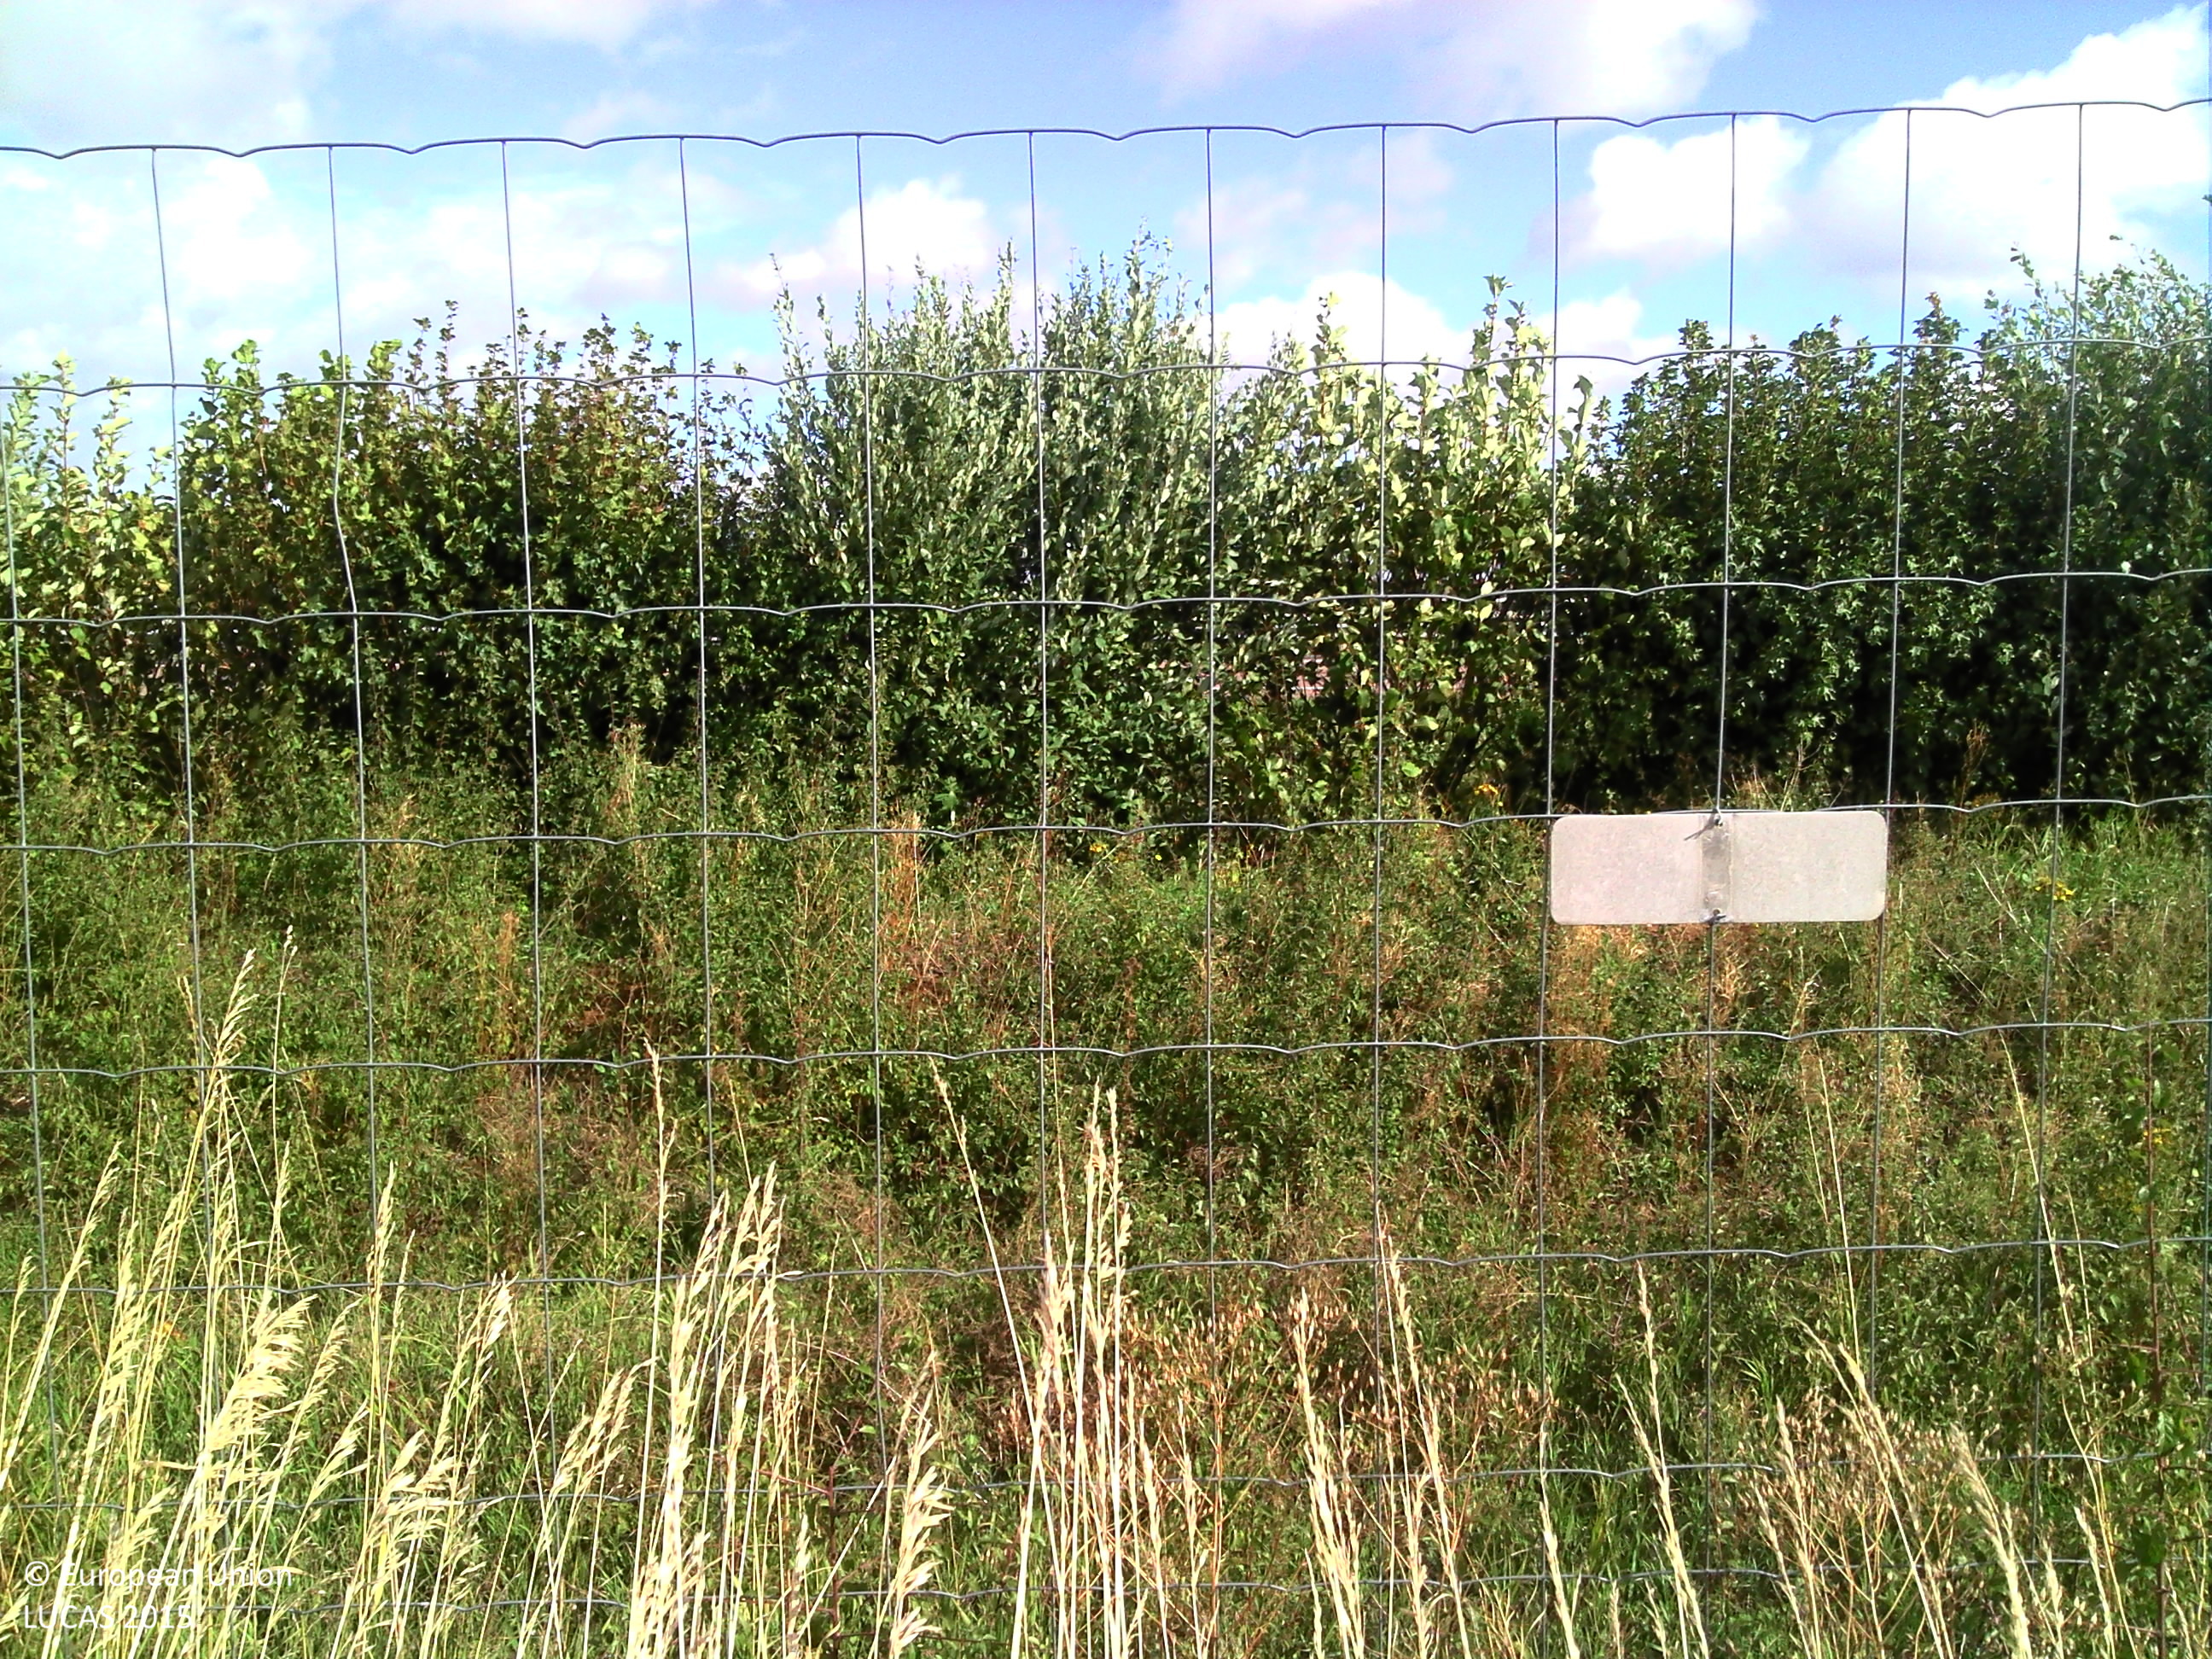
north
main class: Grassland
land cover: Spontaneously vegetated surfaces
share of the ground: > 75 %
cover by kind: herbaceous plants 100 %
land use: Semi-natural and natural areas not in use
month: September
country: FR
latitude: 48.1304
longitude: 4.6640
